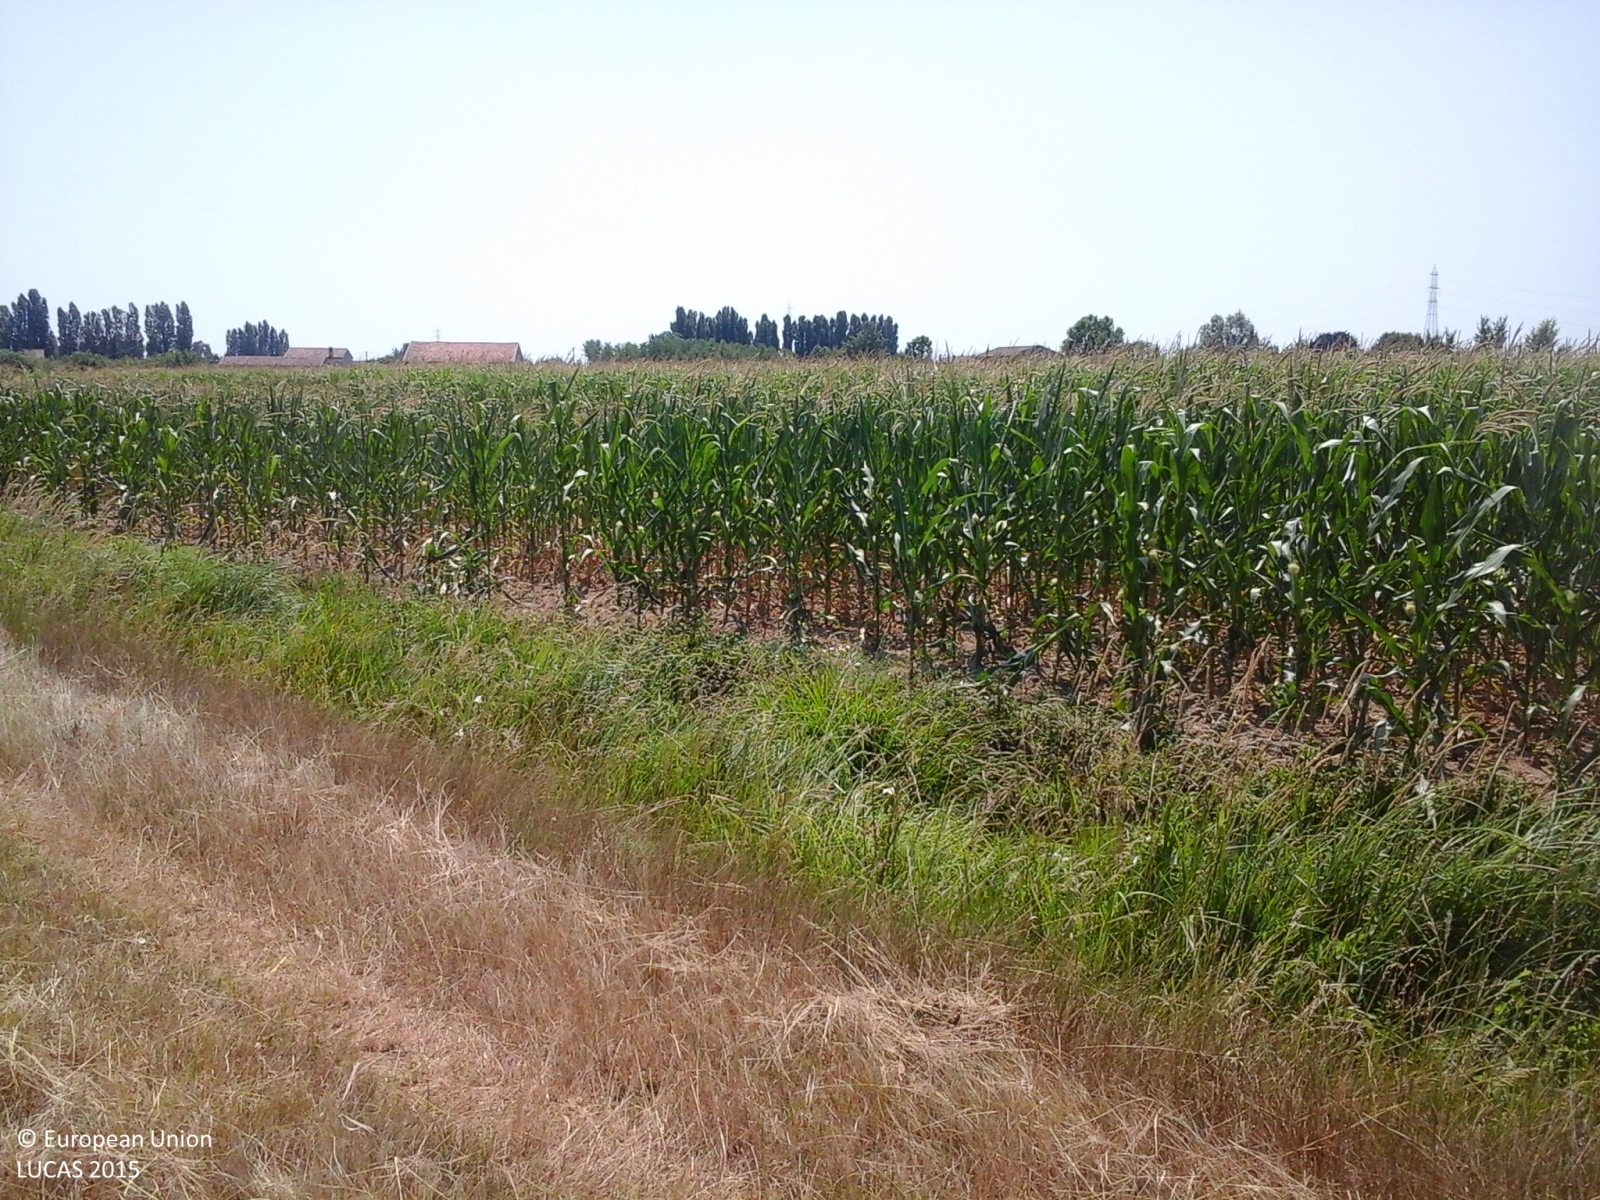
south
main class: Cropland
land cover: Maize
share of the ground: > 75 %
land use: Agriculture (excluding fallow land and kitchen gardens)
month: July
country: IT
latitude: 45.3021
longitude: 10.9293
